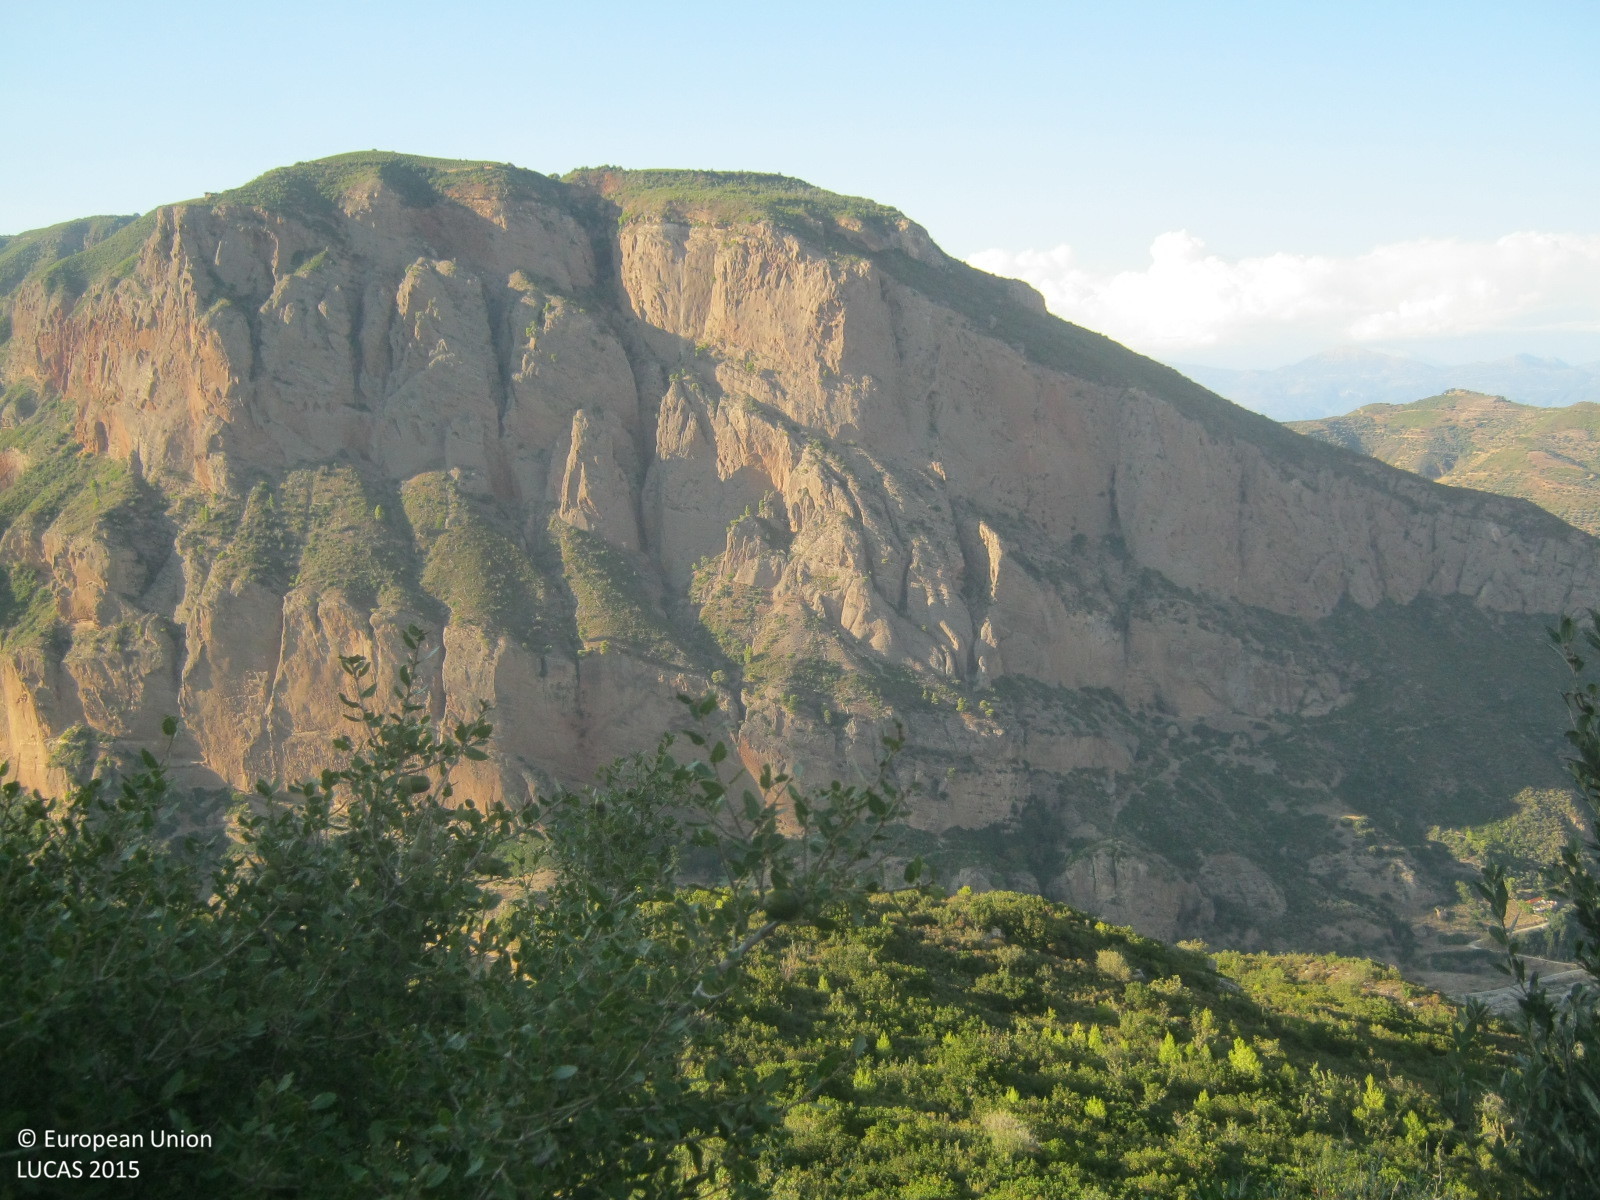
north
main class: Shrubland
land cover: Shrubland without tree cover
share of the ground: > 75 %
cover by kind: shrubs 100 %
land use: Semi-natural and natural areas not in use
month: September
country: GR
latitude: 38.1591
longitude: 22.1234
